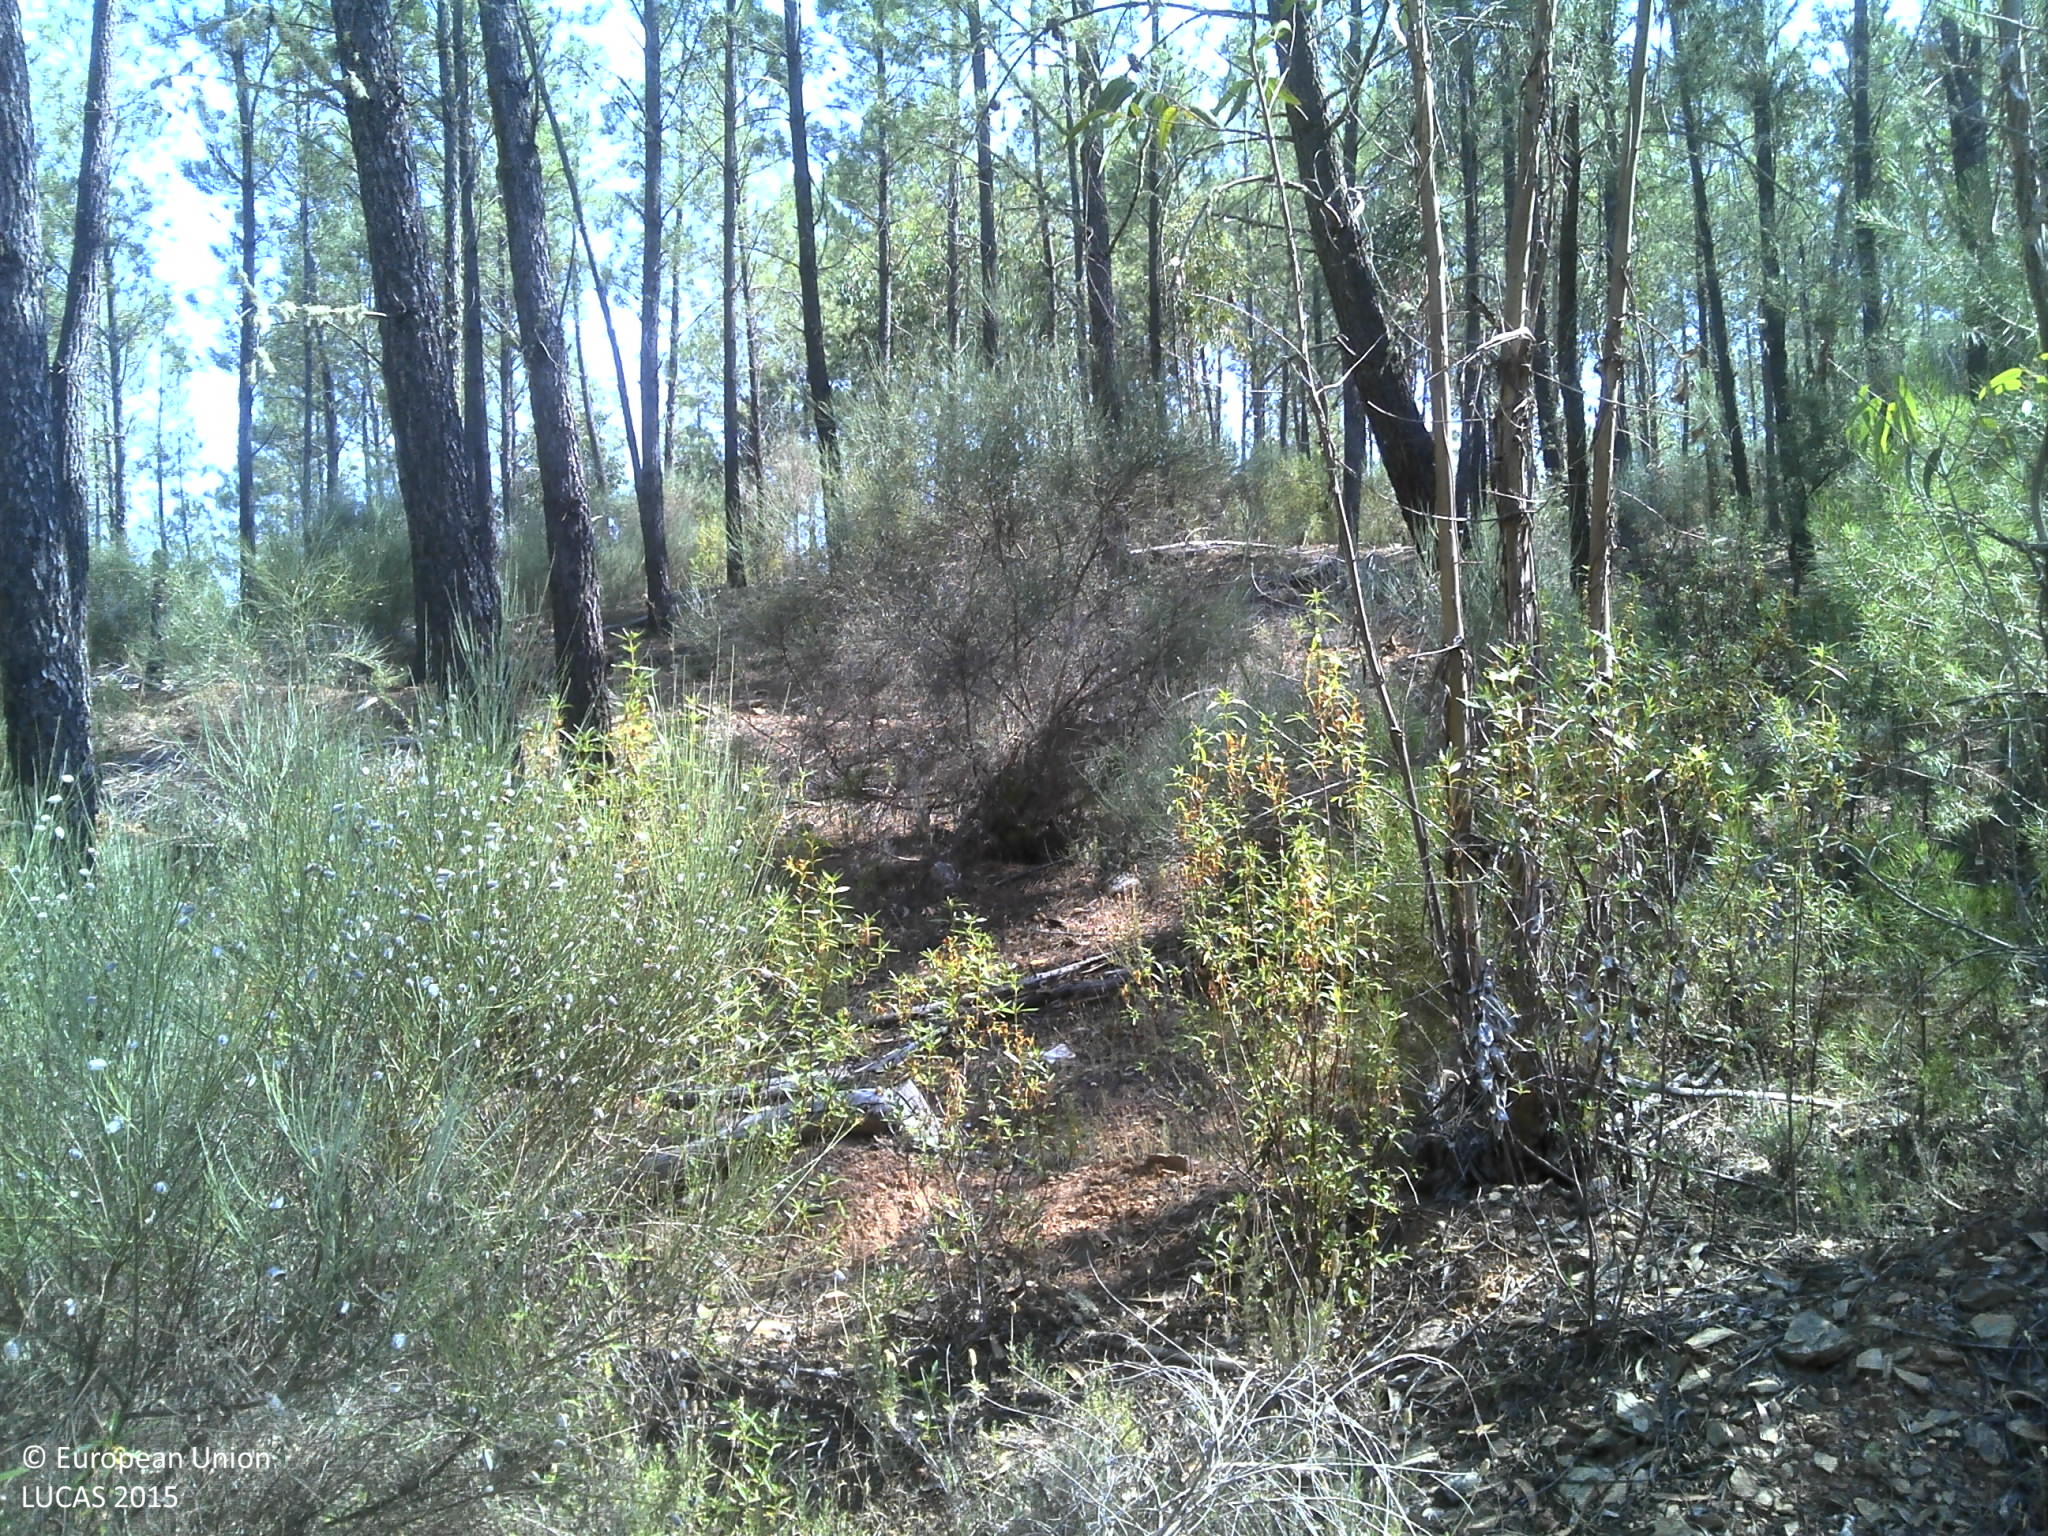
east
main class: Woodland
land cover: Pine dominated coniferous woodland
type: coniferous forest of the mediterranean region
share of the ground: 25 - 50 %
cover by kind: coniferous forest trees 50 %, shrubs 30 %, unconsolidated bare surface 20 %
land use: Forestry
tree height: > 5 m
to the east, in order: Pine dominated coniferous woodland; Tracks; Pine dominated coniferous woodland; Tracks; Pine dominated coniferous woodland
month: June
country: PT
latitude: 40.1078
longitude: -6.9497
